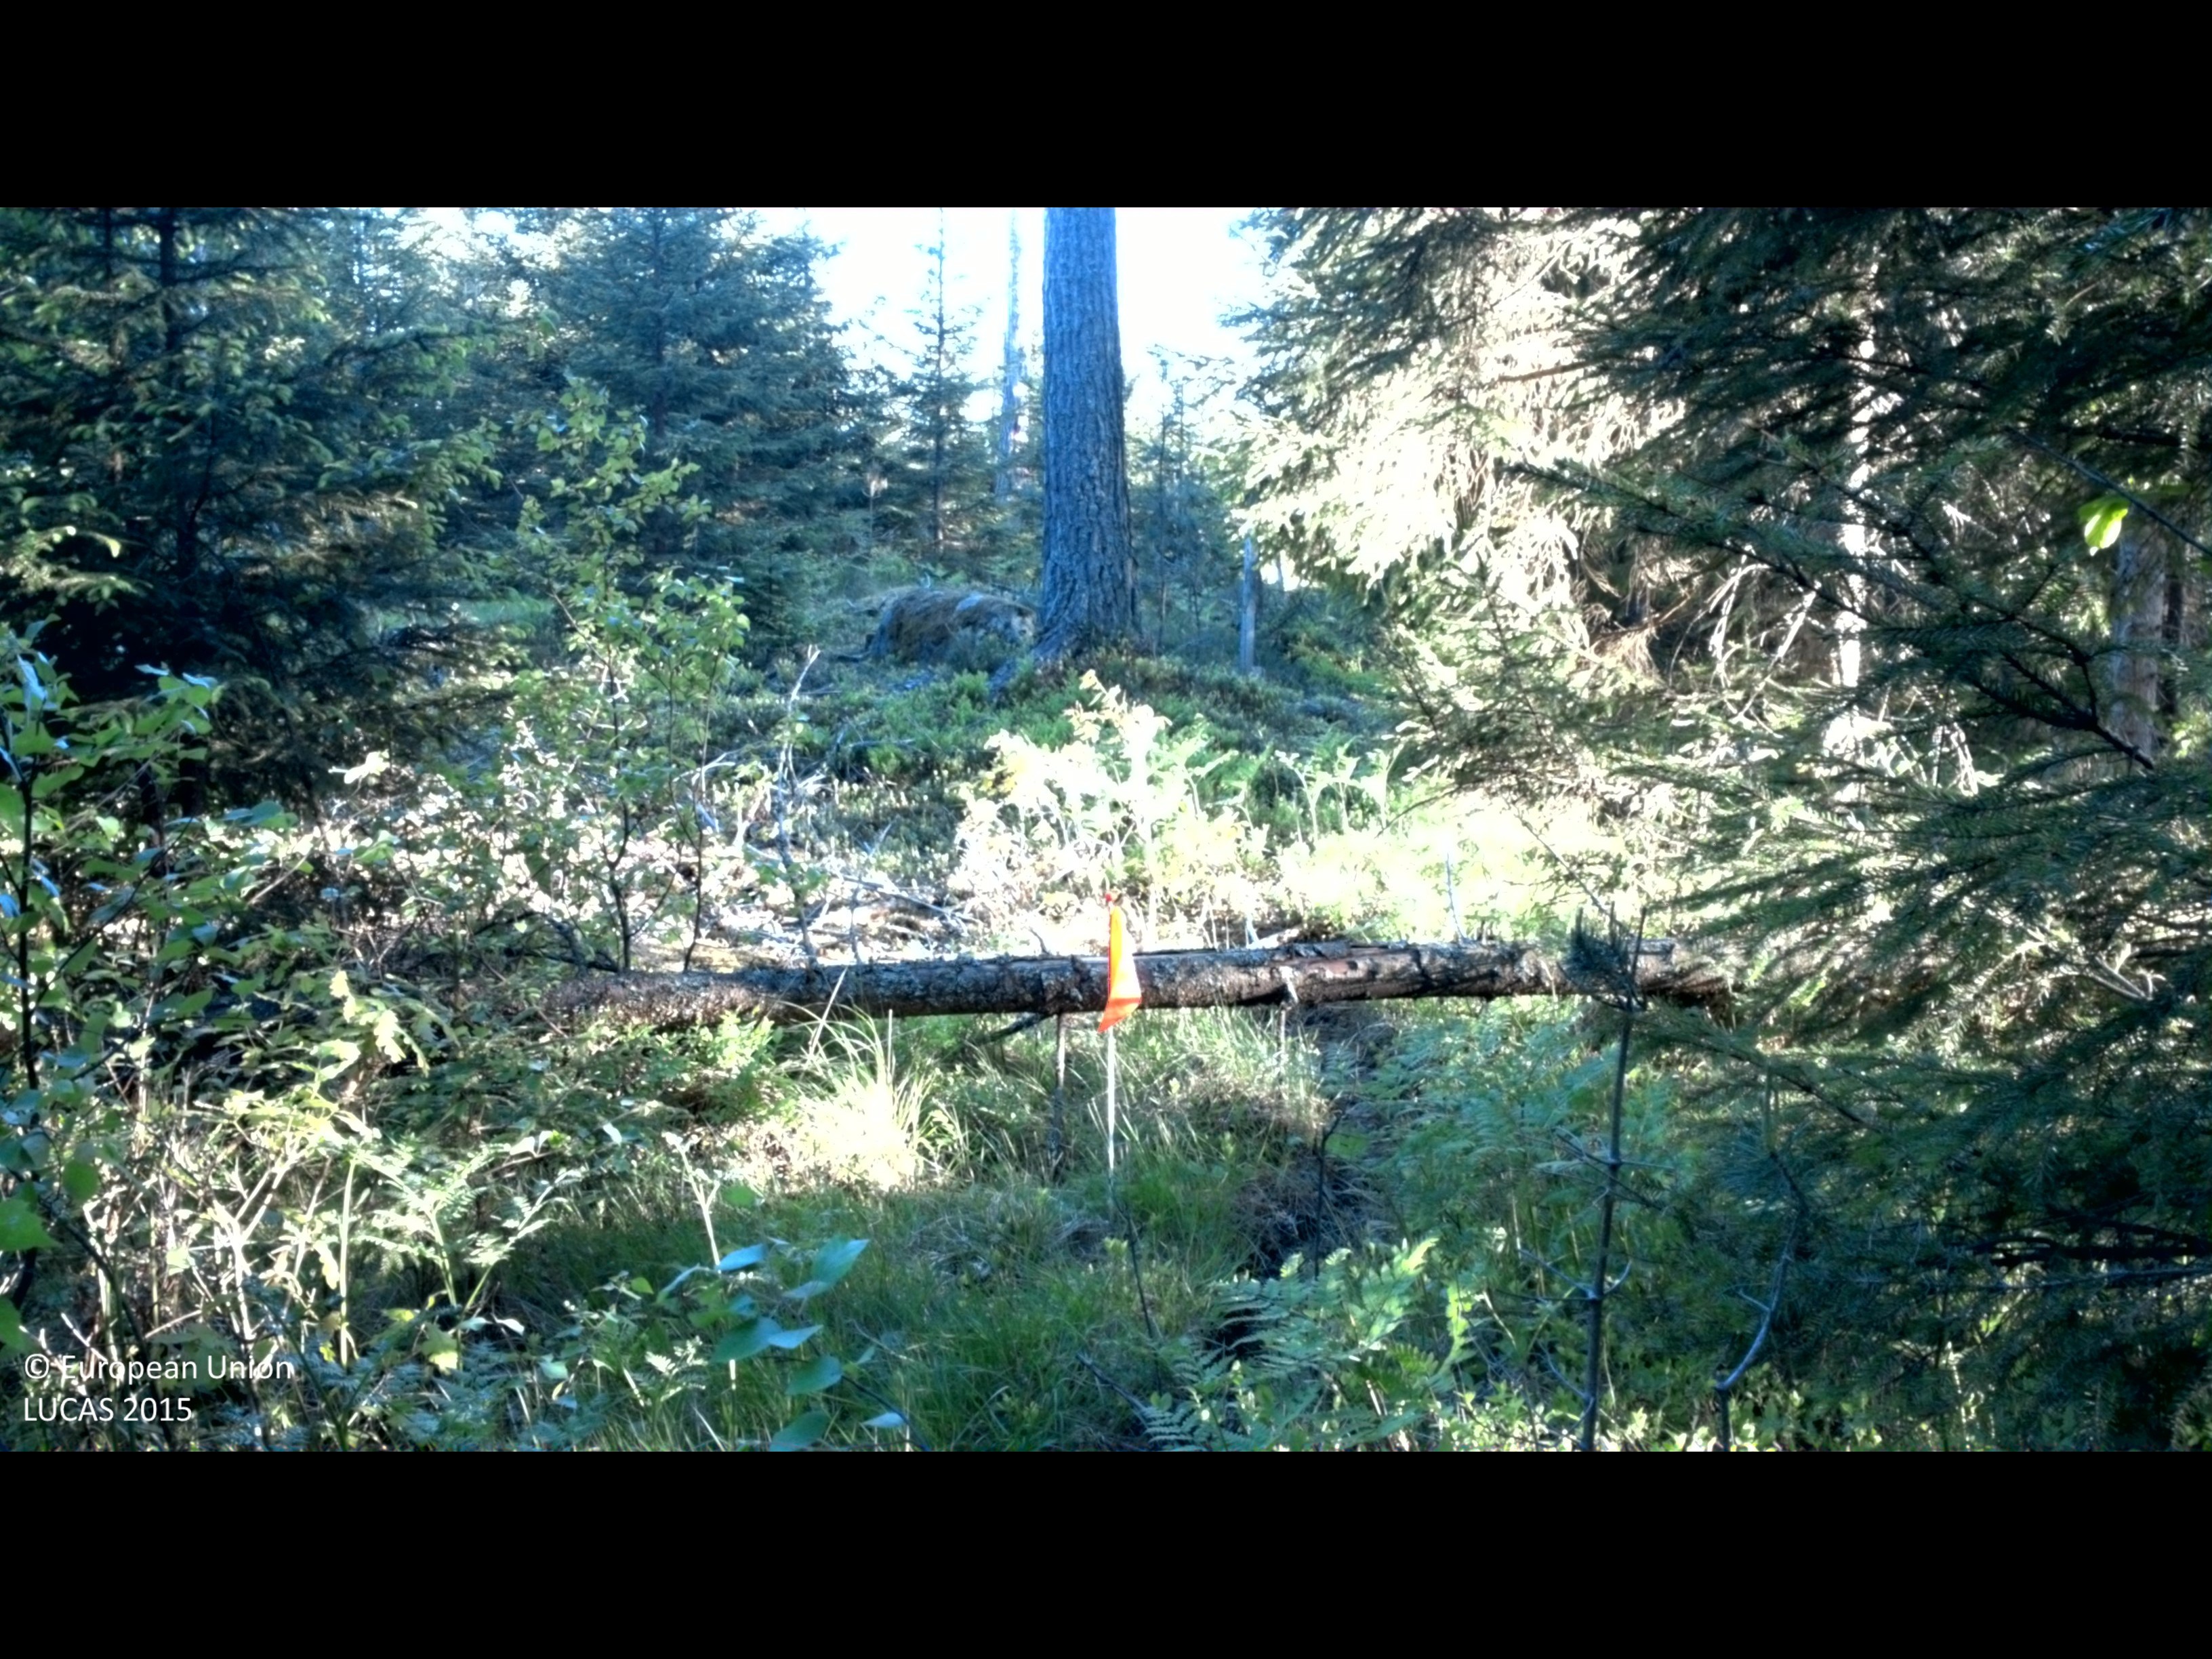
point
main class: Woodland
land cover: Spruce dominated coniferous woodland
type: boreal forest
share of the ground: 50 - 75 %
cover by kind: coniferous forest trees 50 %, shrubs 25 %, broadleaved forest trees 15 %, herbaceous plants 5 %, lichens and mosses 5 %
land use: Forestry
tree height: > 5 m
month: June
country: SE
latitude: 57.8381
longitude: 16.2801
